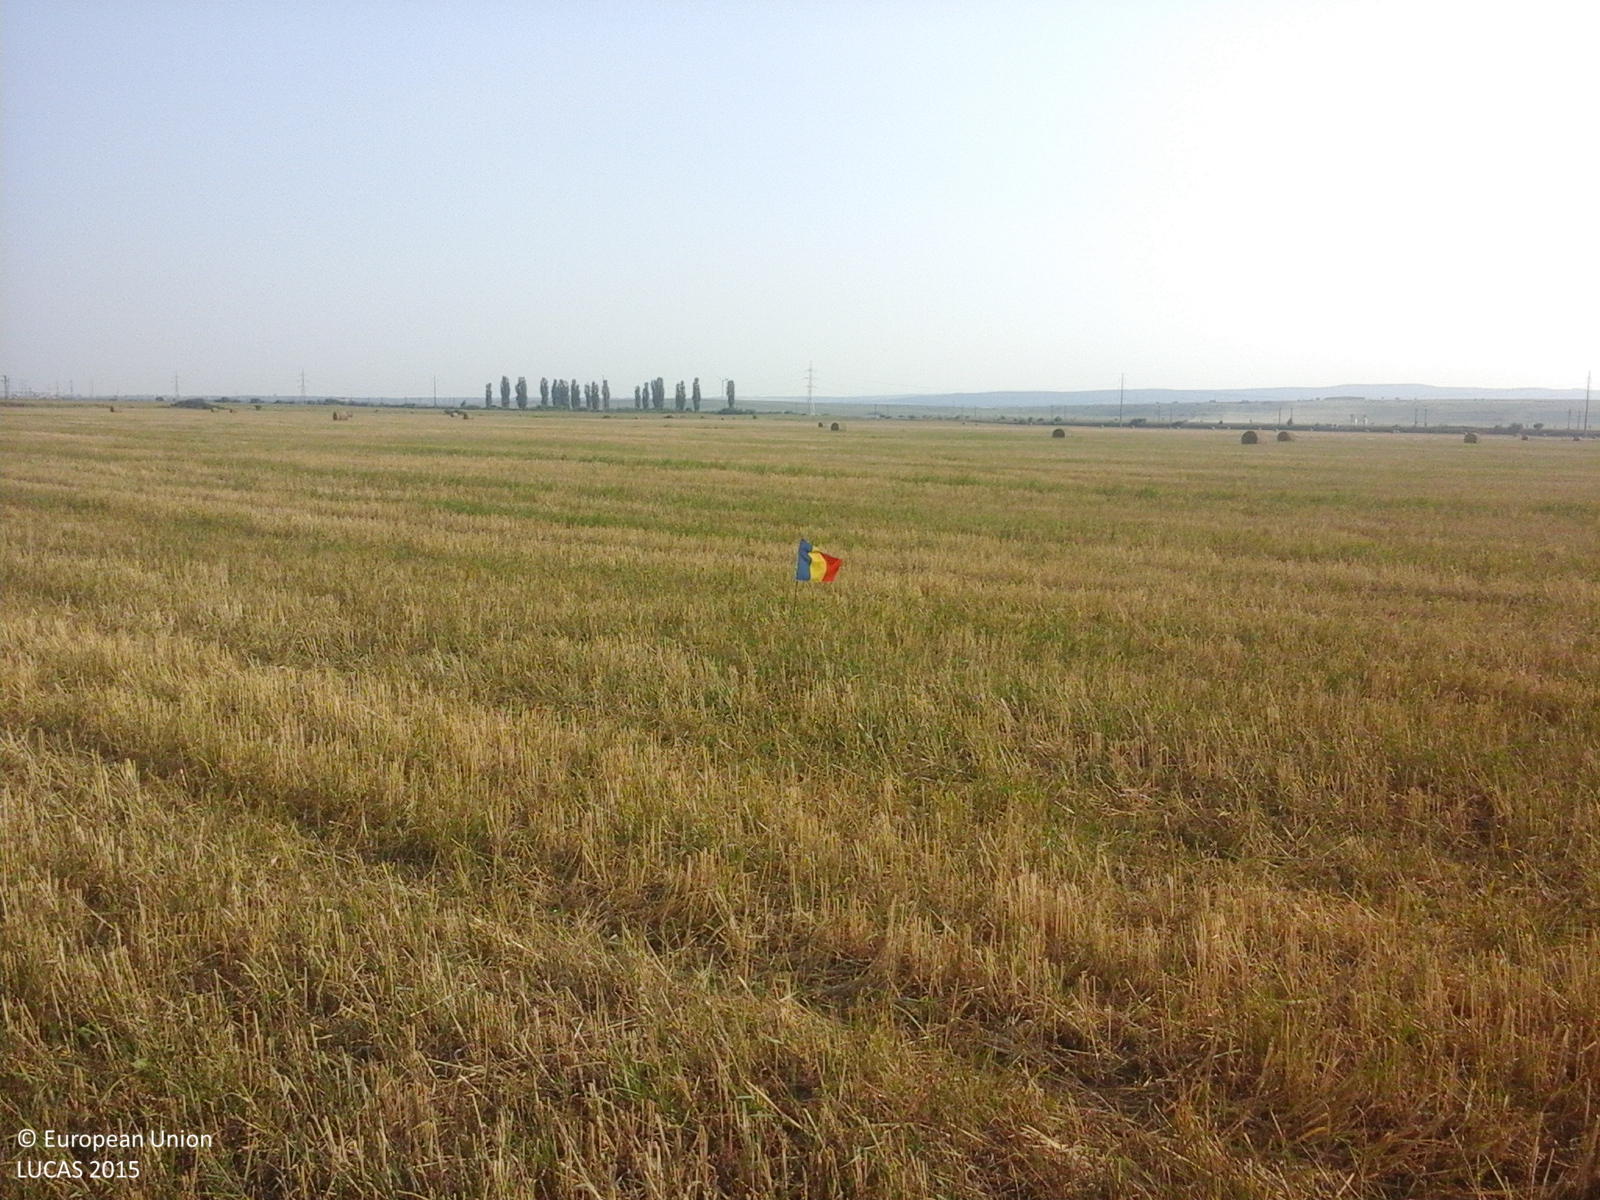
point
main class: Cropland
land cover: Common wheat
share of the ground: 50 - 75 %
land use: Agriculture (excluding fallow land and kitchen gardens)
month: July
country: RO
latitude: 46.1662
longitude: 27.1546
